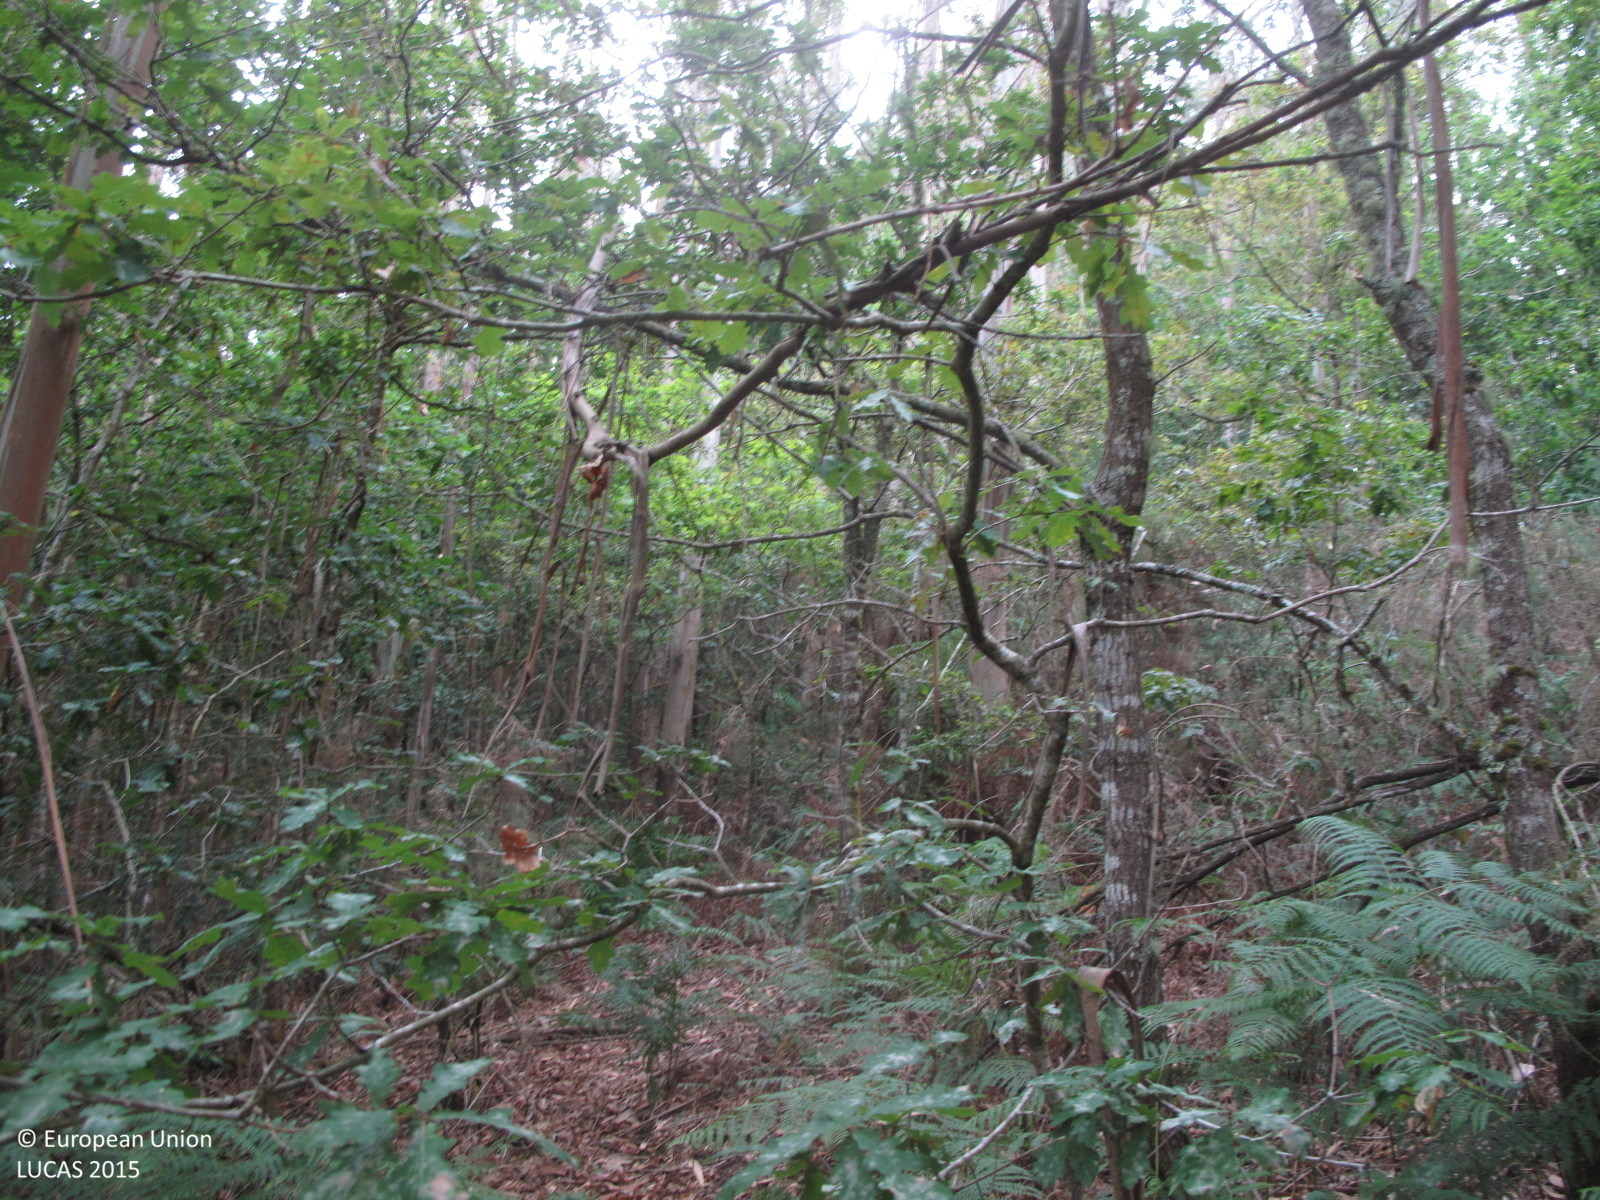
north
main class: Woodland
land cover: Broadleaved woodland
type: acidophilous oak and oak-birch forest
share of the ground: > 75 %
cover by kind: broadleaved forest trees 90 %, herbaceous plants 10 %
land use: Forestry
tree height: > 5 m
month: July
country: ES
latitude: 43.2514
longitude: -8.0402
